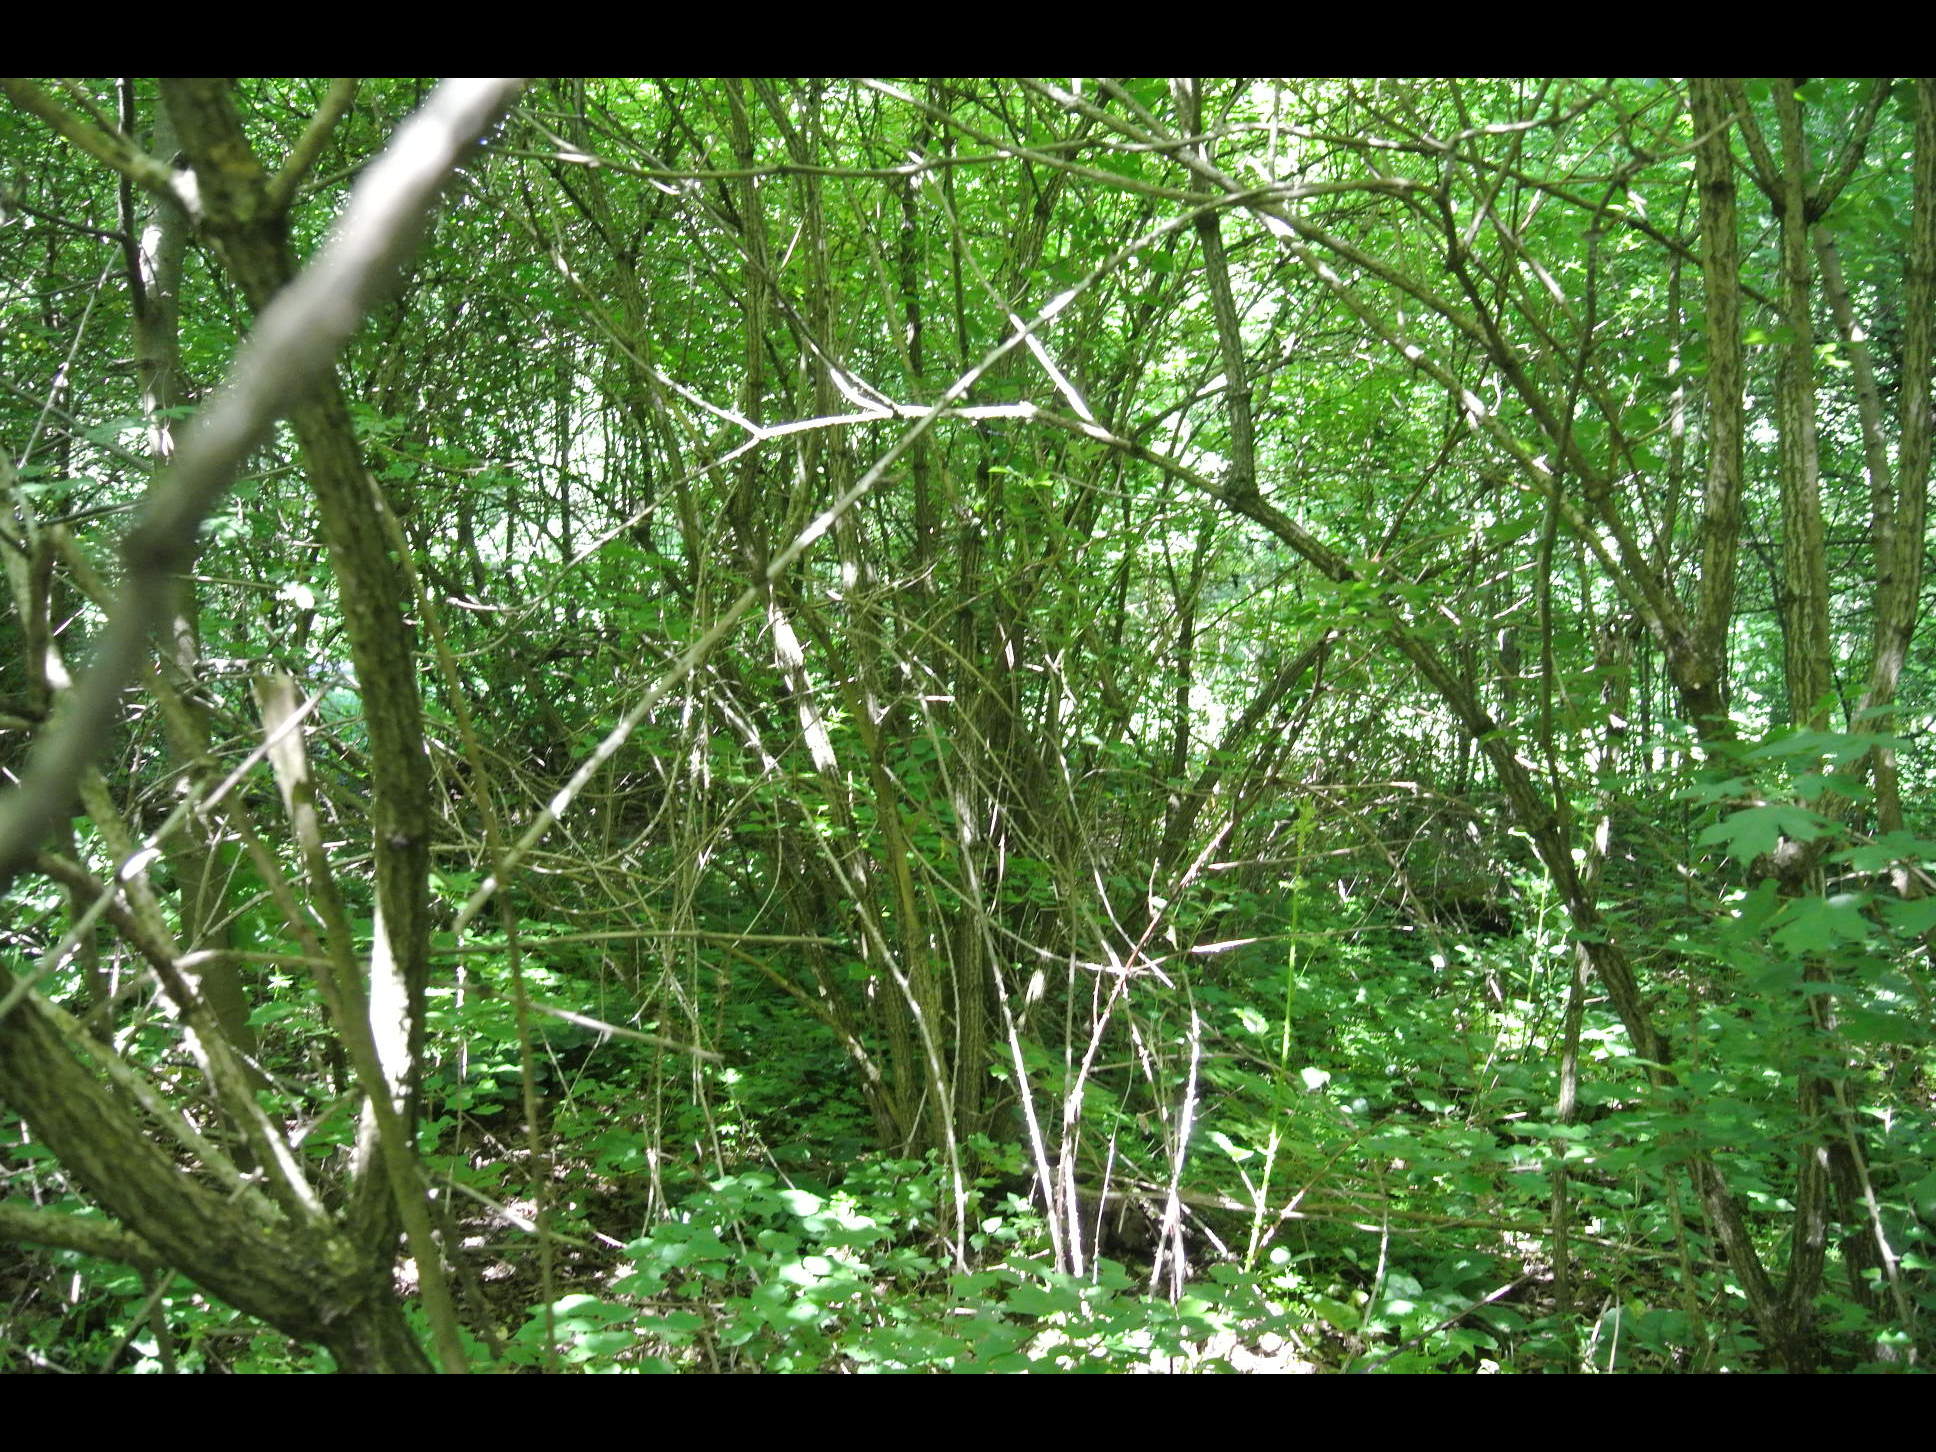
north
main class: Woodland
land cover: Broadleaved woodland
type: mesophytic deciduous forest
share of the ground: > 75 %
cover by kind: broadleaved forest trees 90 %, shrubs 10 %
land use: Forestry
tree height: > 5 m
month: May
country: AT
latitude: 47.9515
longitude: 16.6335
